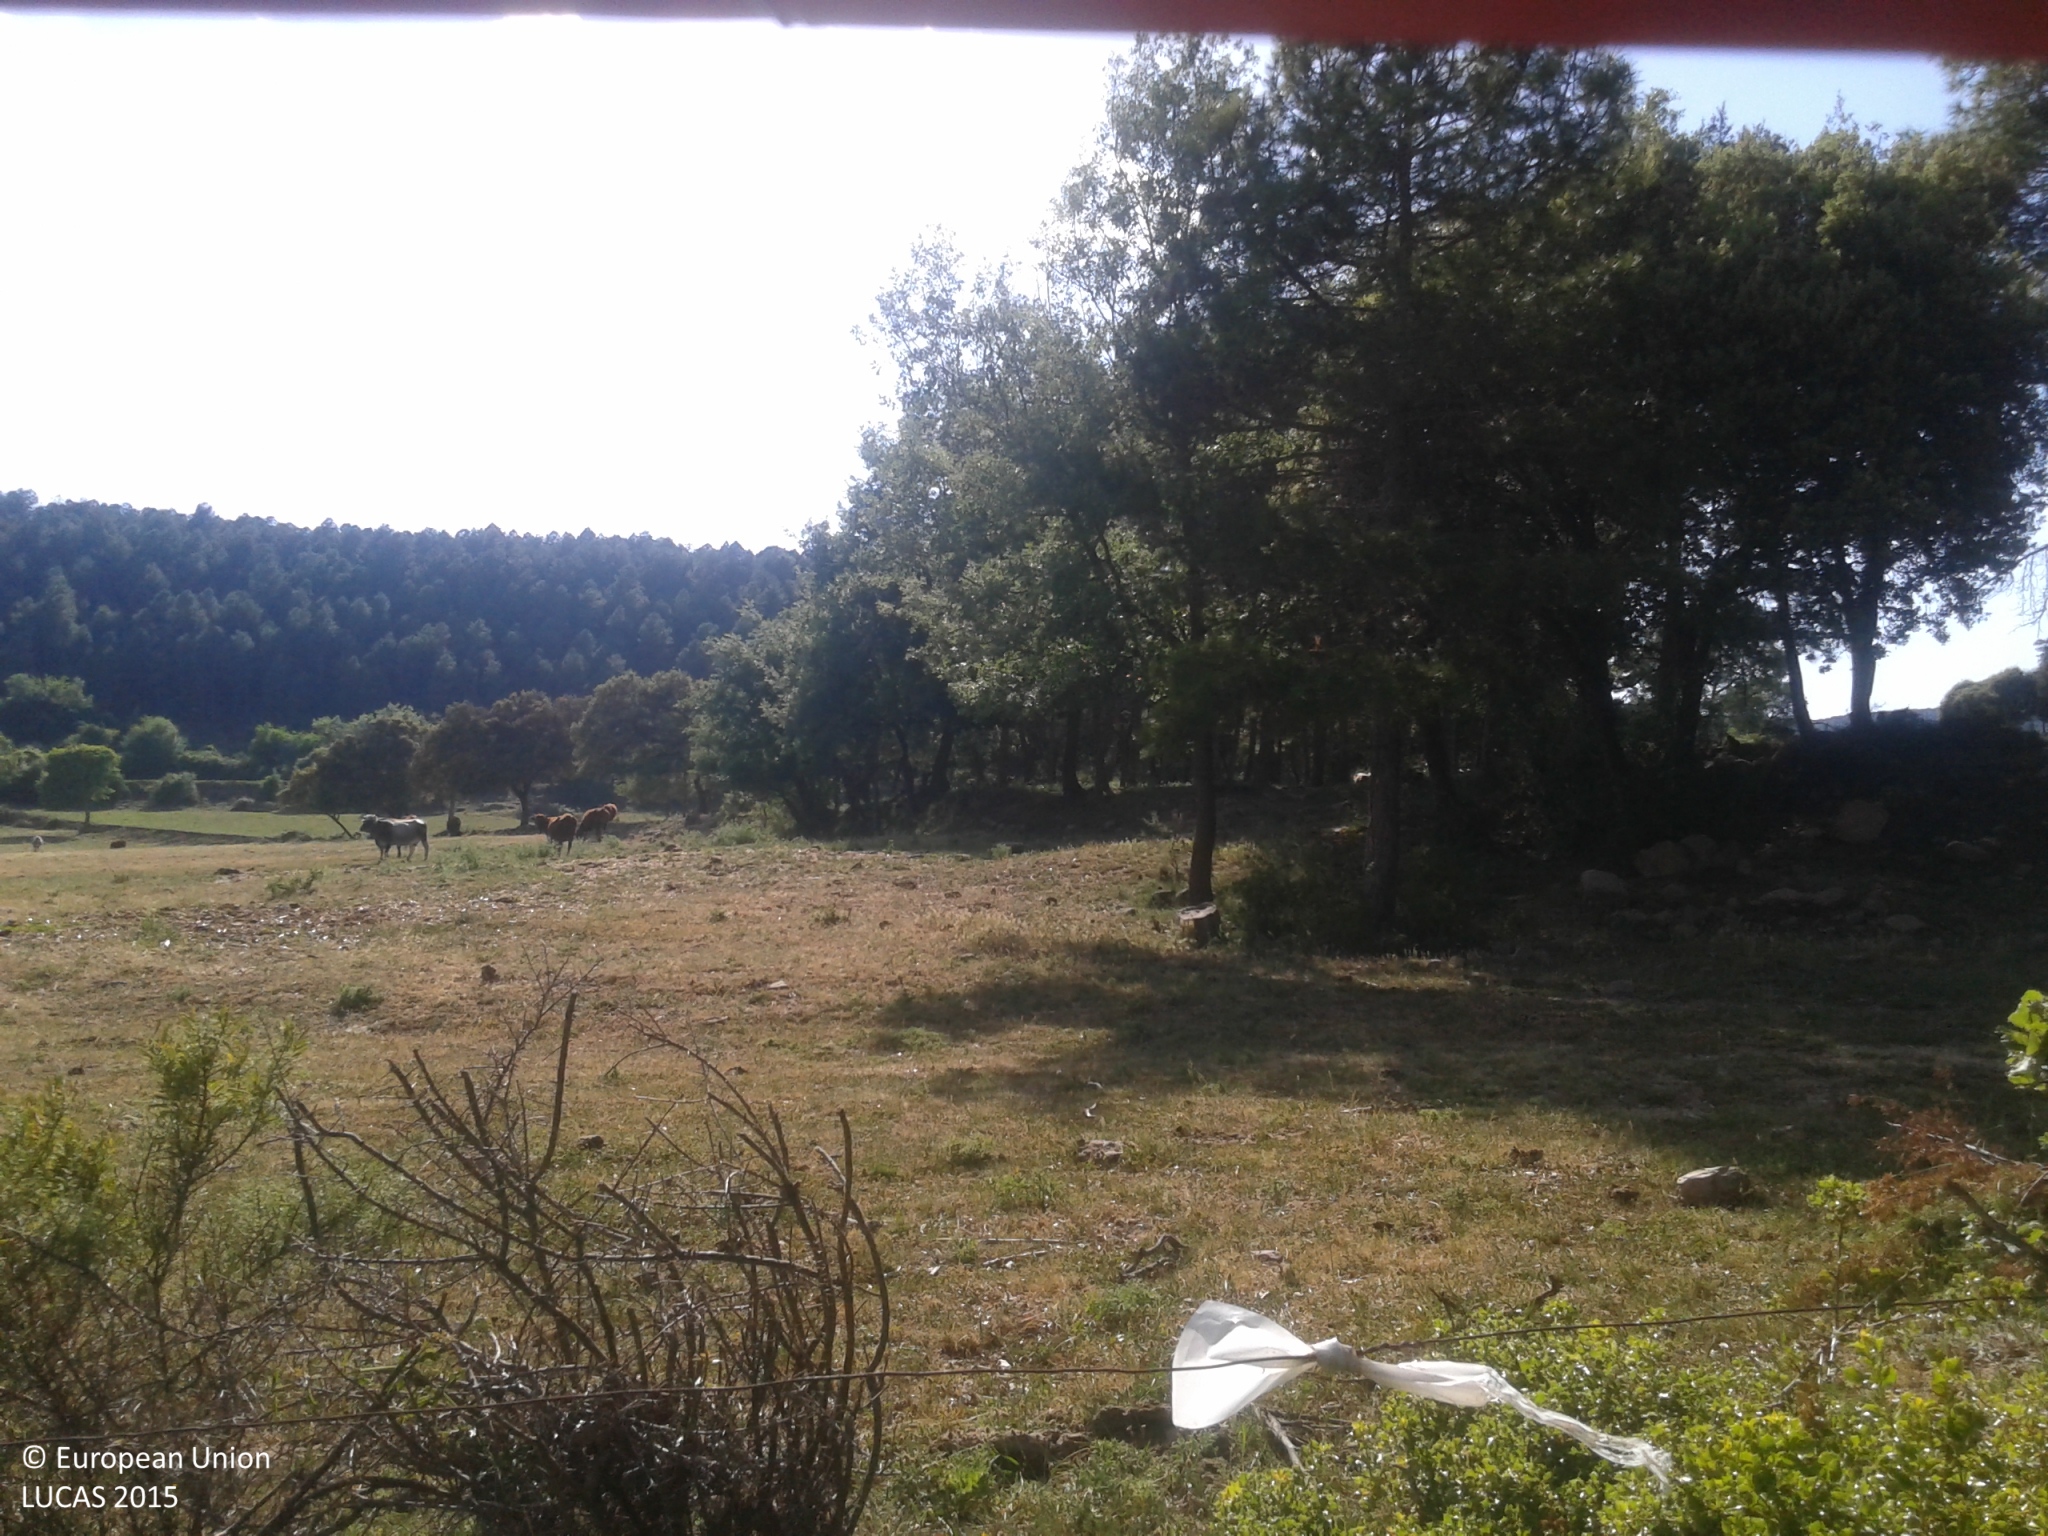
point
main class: Grassland
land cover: Grassland without tree/shrub cover
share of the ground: > 75 %
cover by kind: herbaceous plants 100 %
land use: Agriculture (excluding fallow land and kitchen gardens)
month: May
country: ES
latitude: 42.0378
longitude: 1.6655
